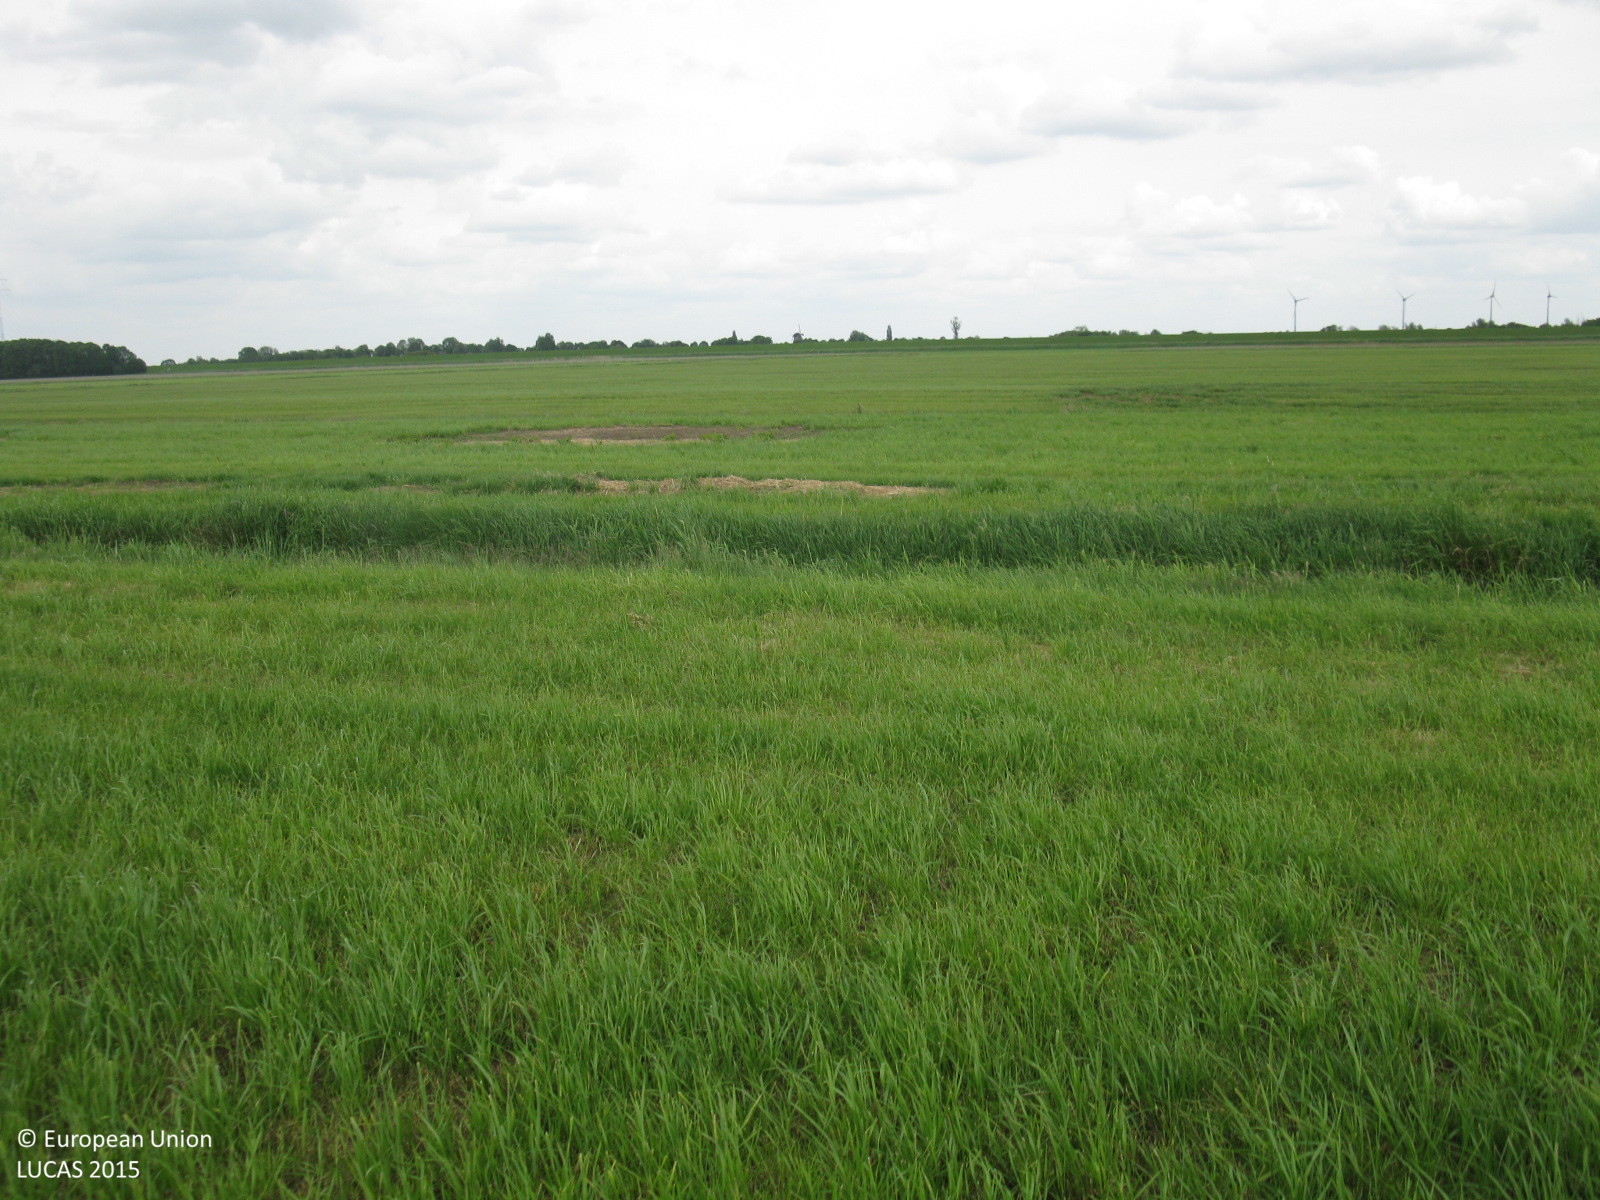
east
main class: Grassland
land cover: Grassland without tree/shrub cover
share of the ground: > 75 %
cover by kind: herbaceous plants 100 %
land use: Agriculture (excluding fallow land and kitchen gardens)
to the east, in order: Grassland without tree/shrub cover; Ditches and canals; Grassland without tree/shrub cover; Ditches and canals; Grassland without tree/shrub cover
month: June
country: DE
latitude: 53.1393
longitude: 7.3546
